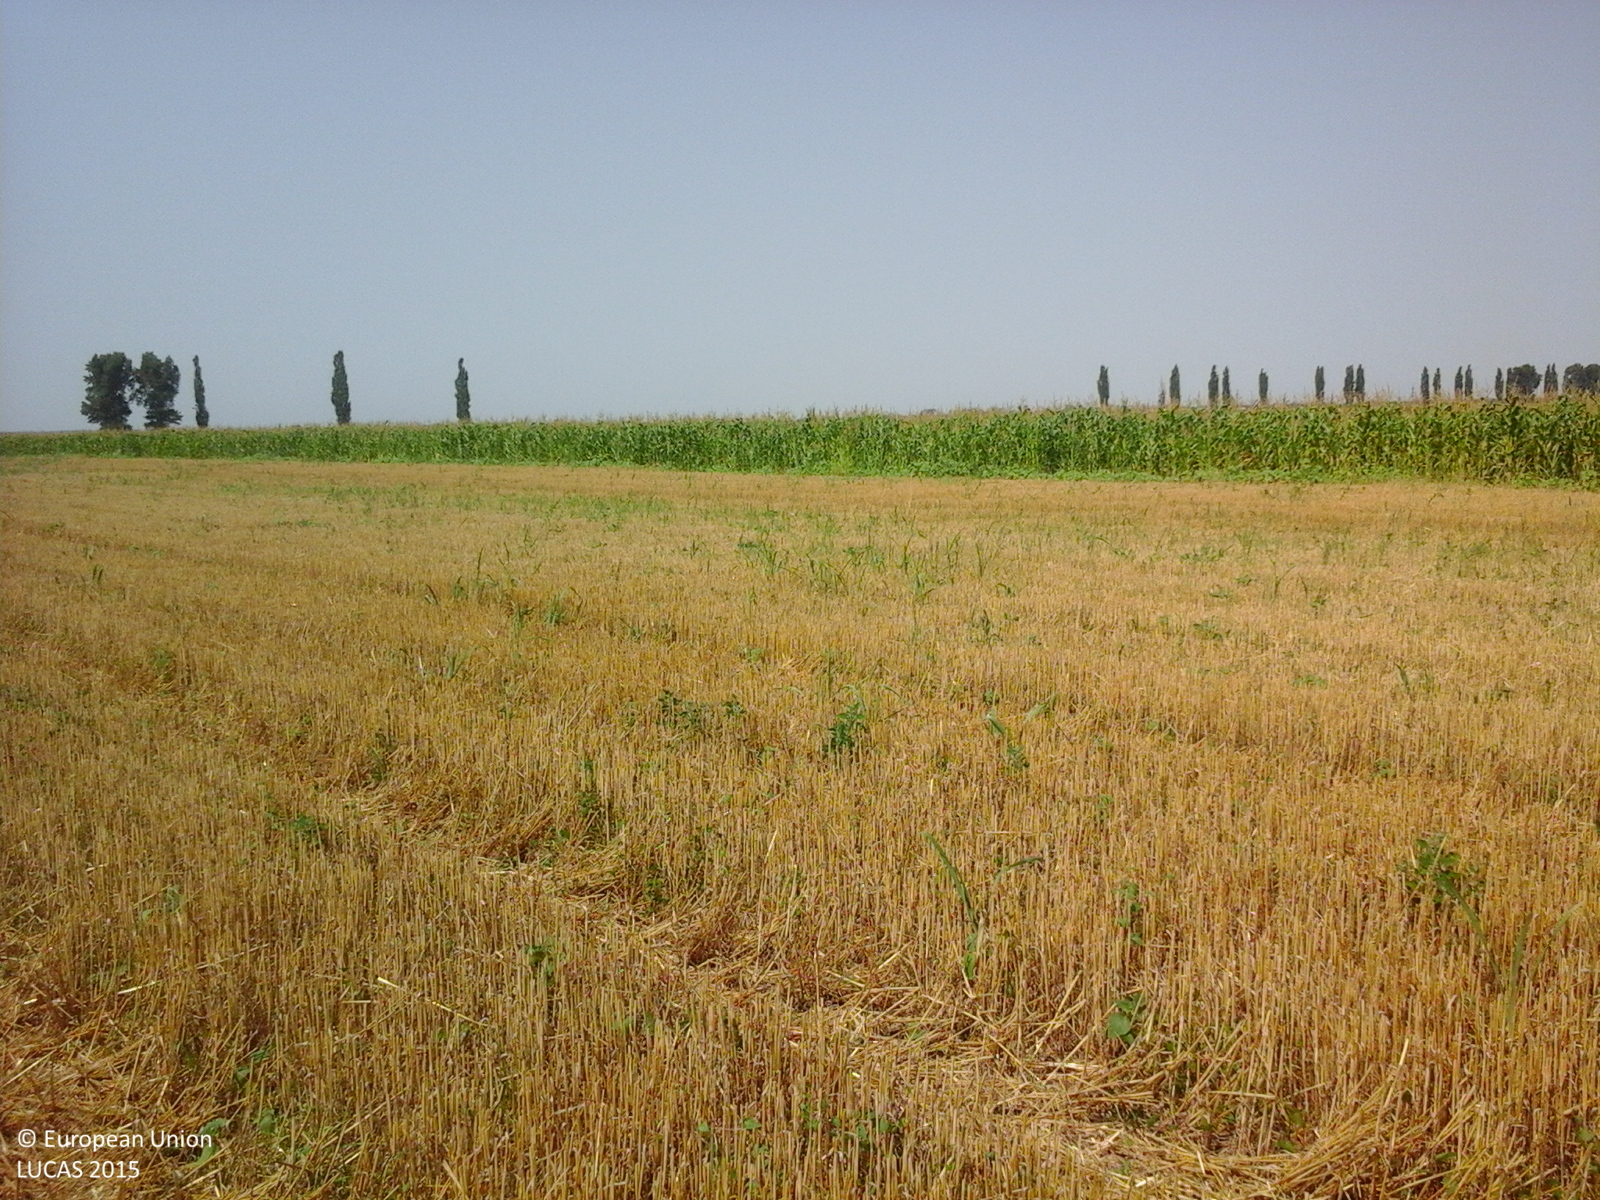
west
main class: Cropland
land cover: Durum wheat
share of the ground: 25 - 50 %
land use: Agriculture (excluding fallow land and kitchen gardens)
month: July
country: RO
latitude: 44.6331
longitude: 26.5175
